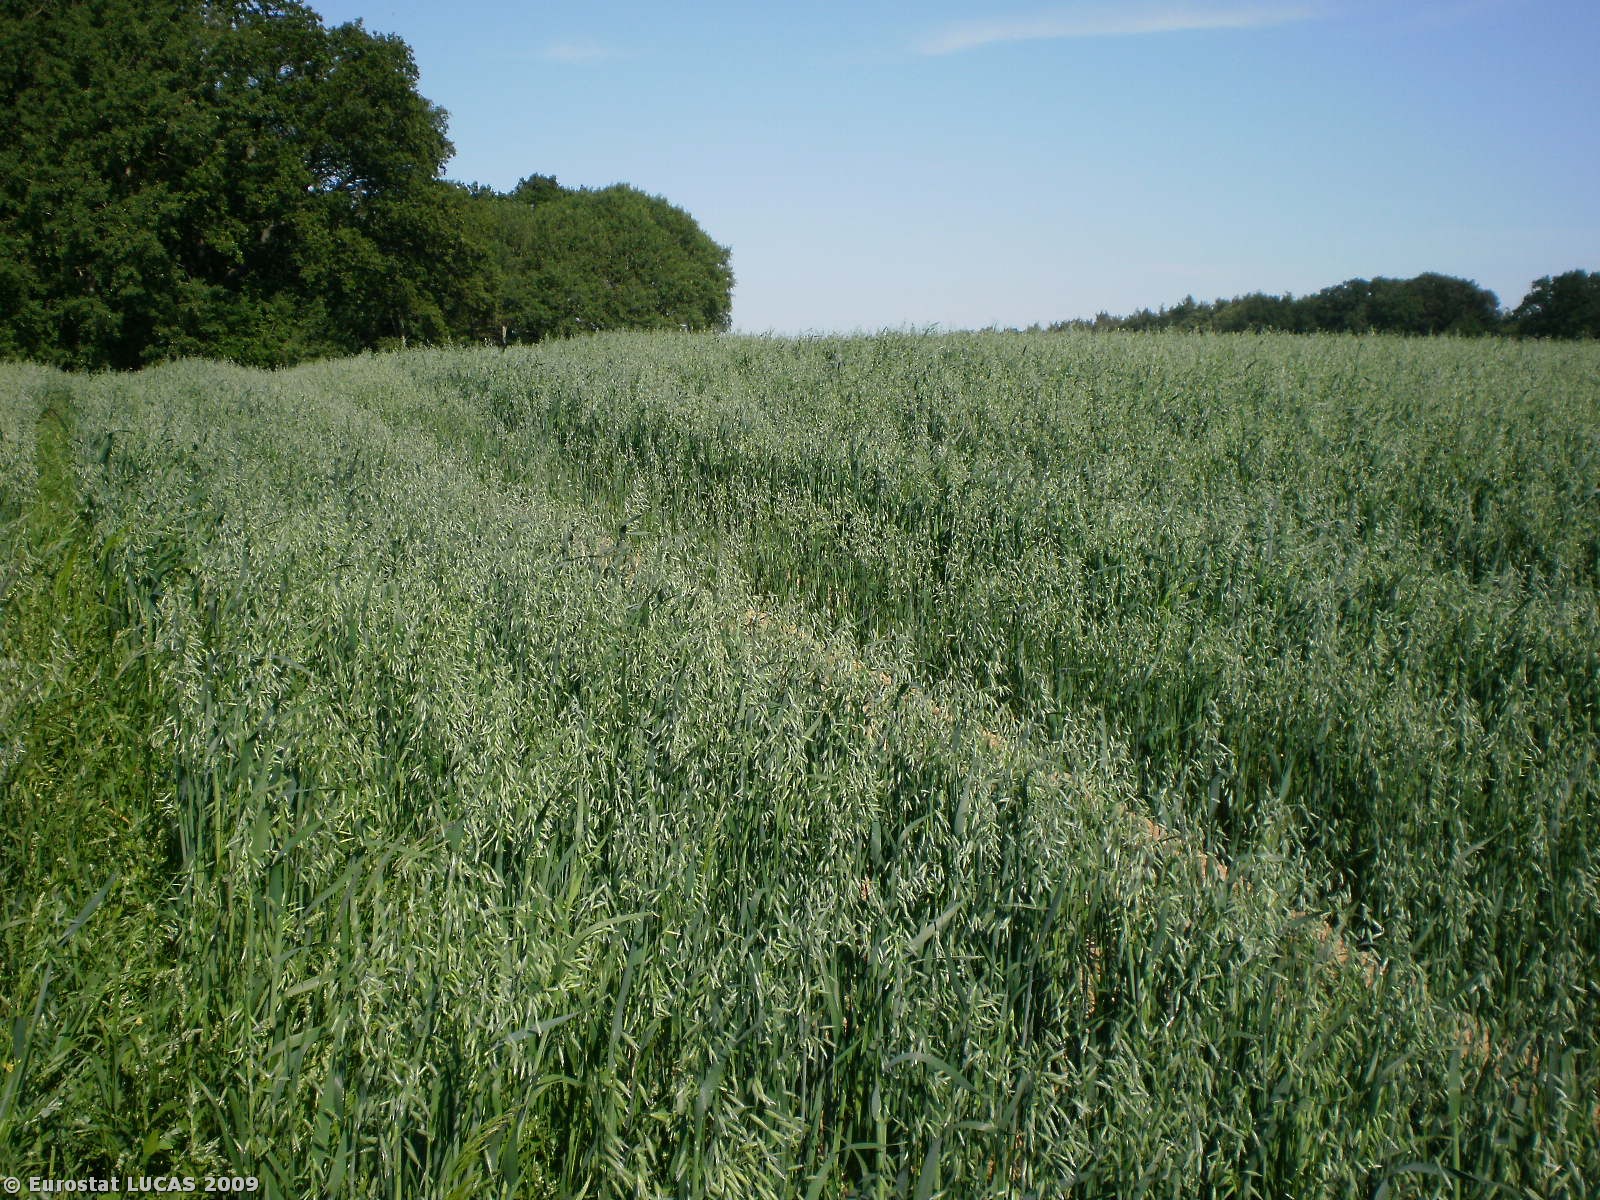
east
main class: Cropland
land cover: Oats
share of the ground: > 75 %
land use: Agriculture (excluding fallow land and kitchen gardens)
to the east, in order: Oats; Grass margins; Fences; Grassland with sparse tree/shrub cover; Fences; Broadleaved woodland; Fences; Grassland with sparse tree/shrub cover
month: June
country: PL
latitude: 54.6236
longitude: 17.3353
